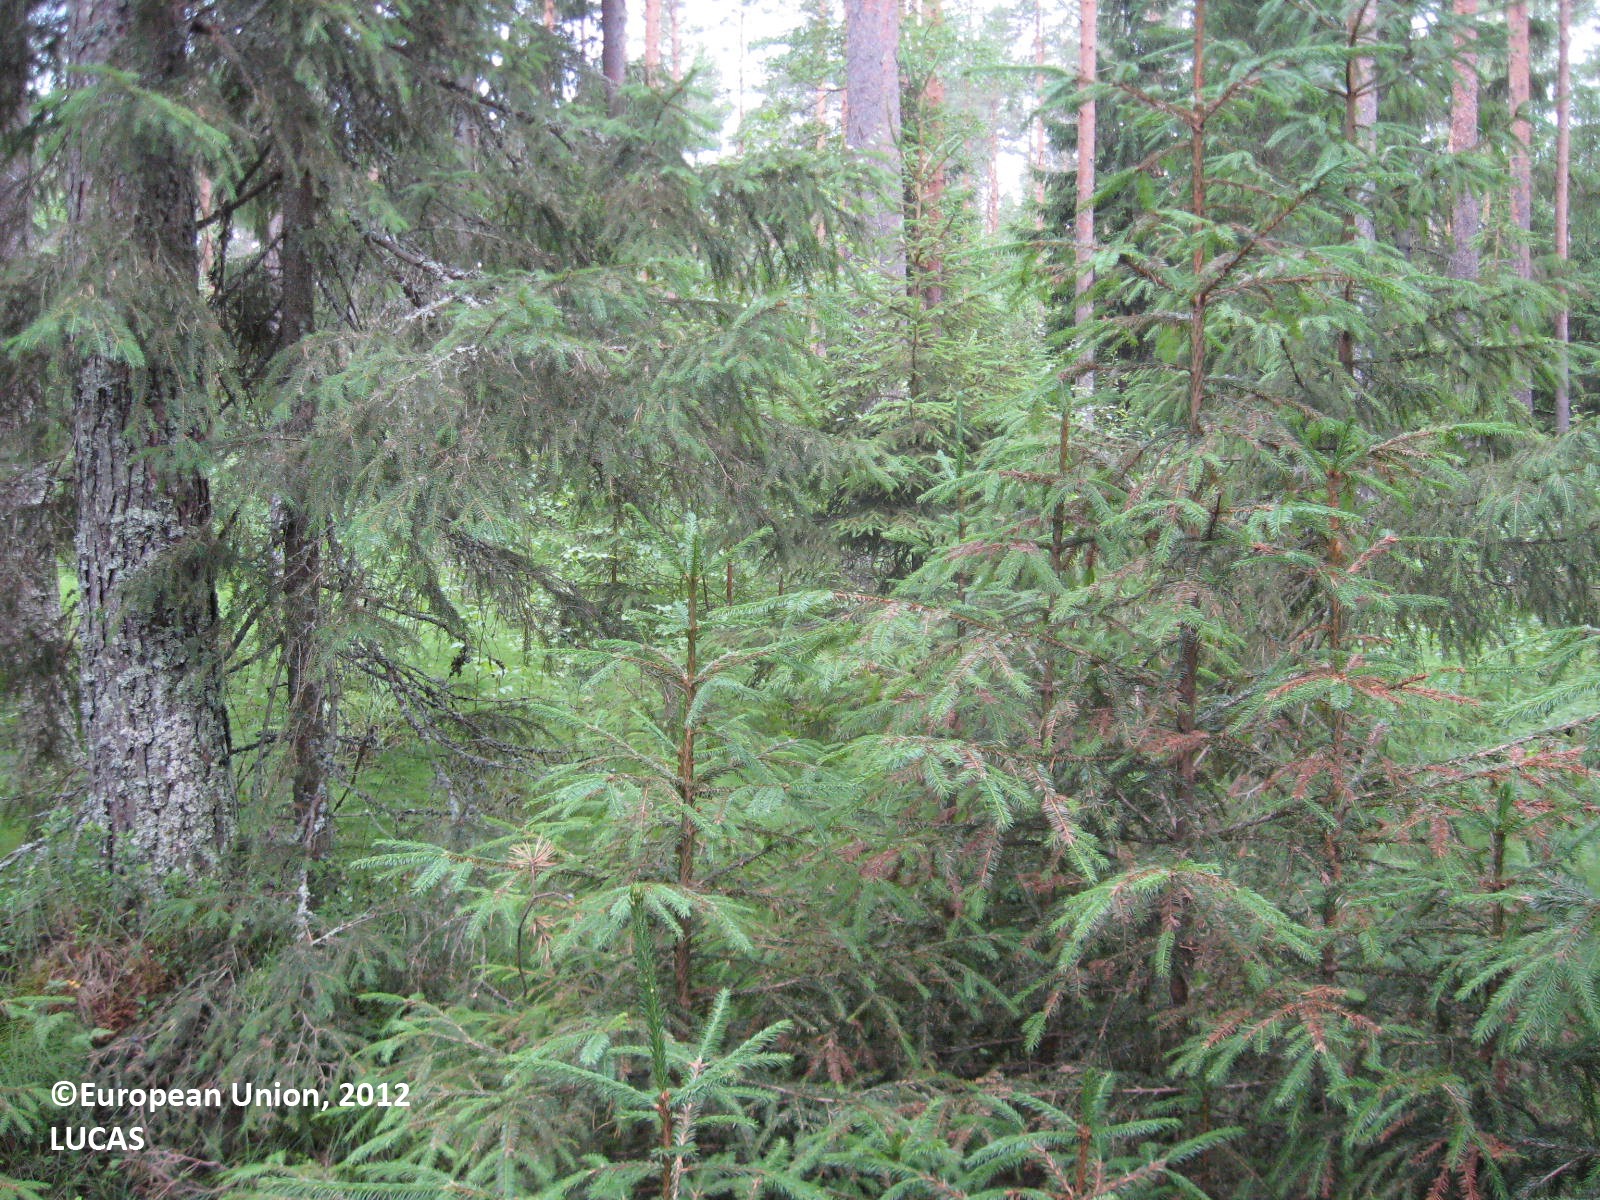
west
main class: Woodland
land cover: Other coniferous woodland
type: boreal forest
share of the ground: > 75 %
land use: Forestry
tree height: > 5 m
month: July
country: FI
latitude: 62.3588
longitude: 21.6583
